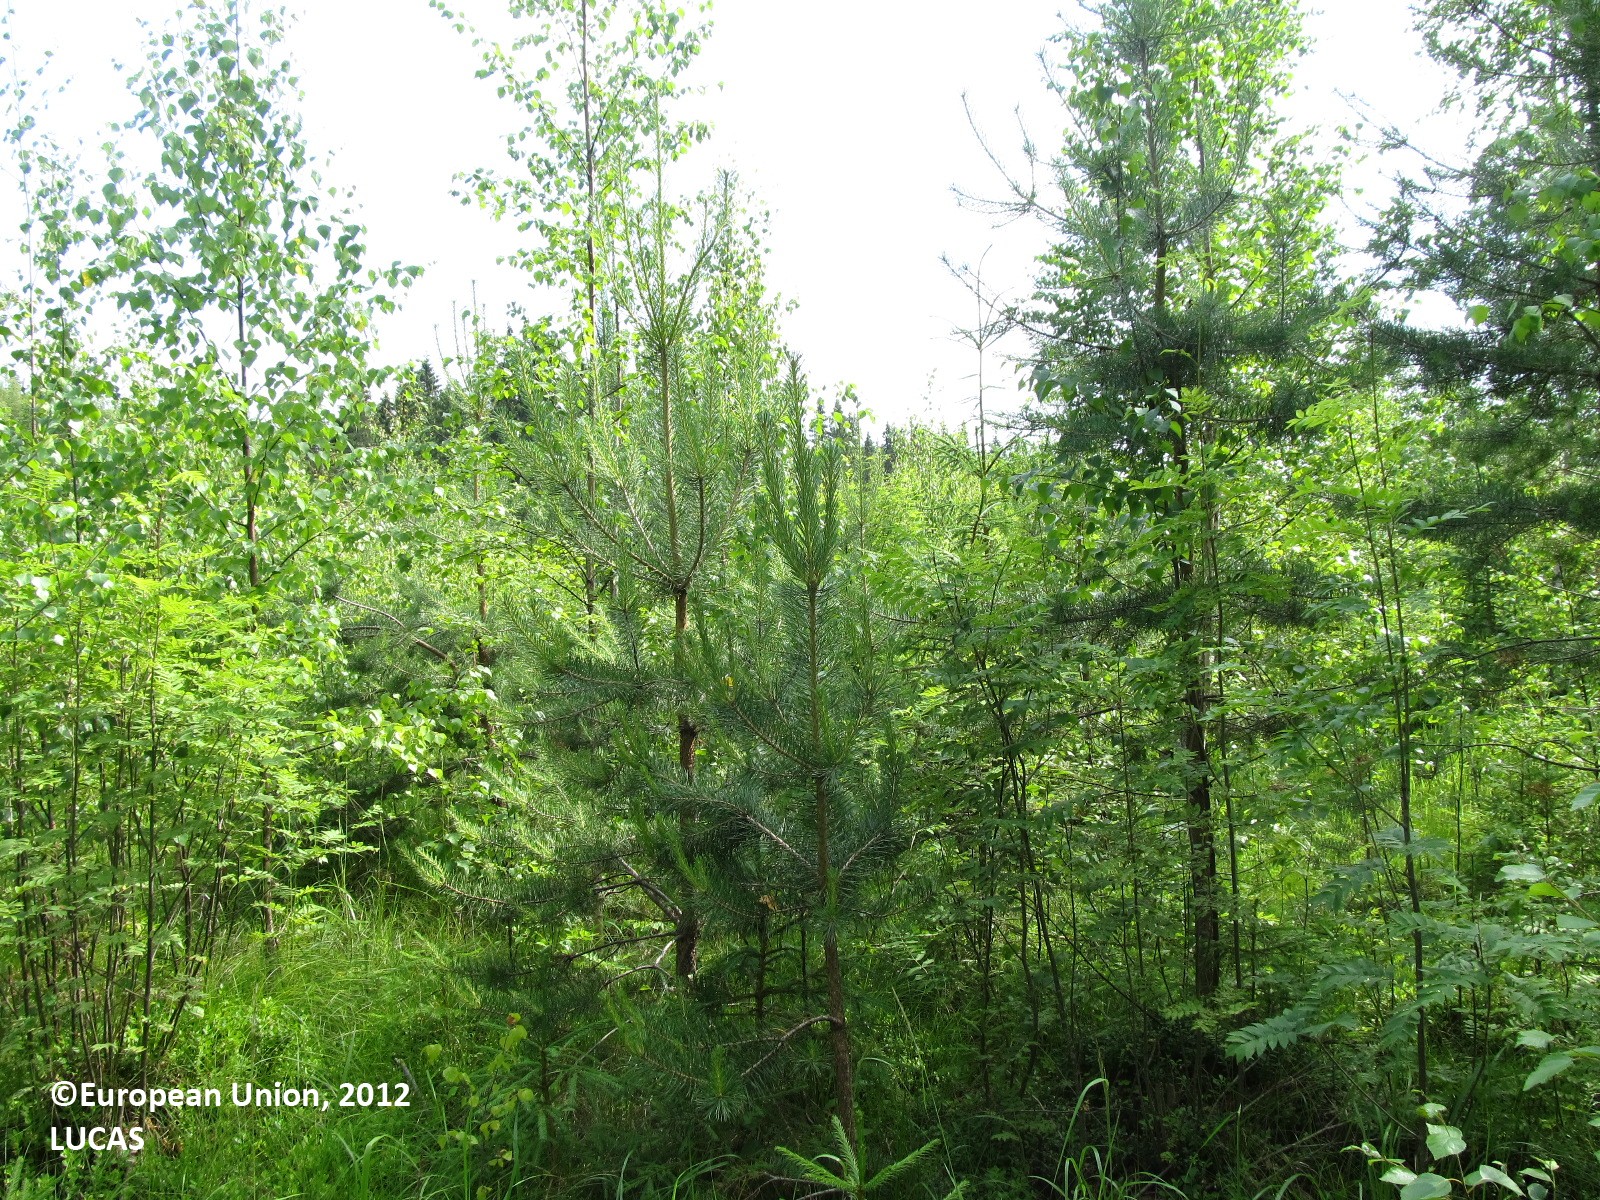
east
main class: Woodland
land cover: Pine dominated mixed woodland
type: boreal forest
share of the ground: 25 - 50 %
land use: Forestry
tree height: < 5 m
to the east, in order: Pine dominated mixed woodland; Shrubland without tree cover; Electric lines; Shrubland without tree cover; Spruce dominated coniferous woodland
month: July
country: FI
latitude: 61.9286
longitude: 29.1081
